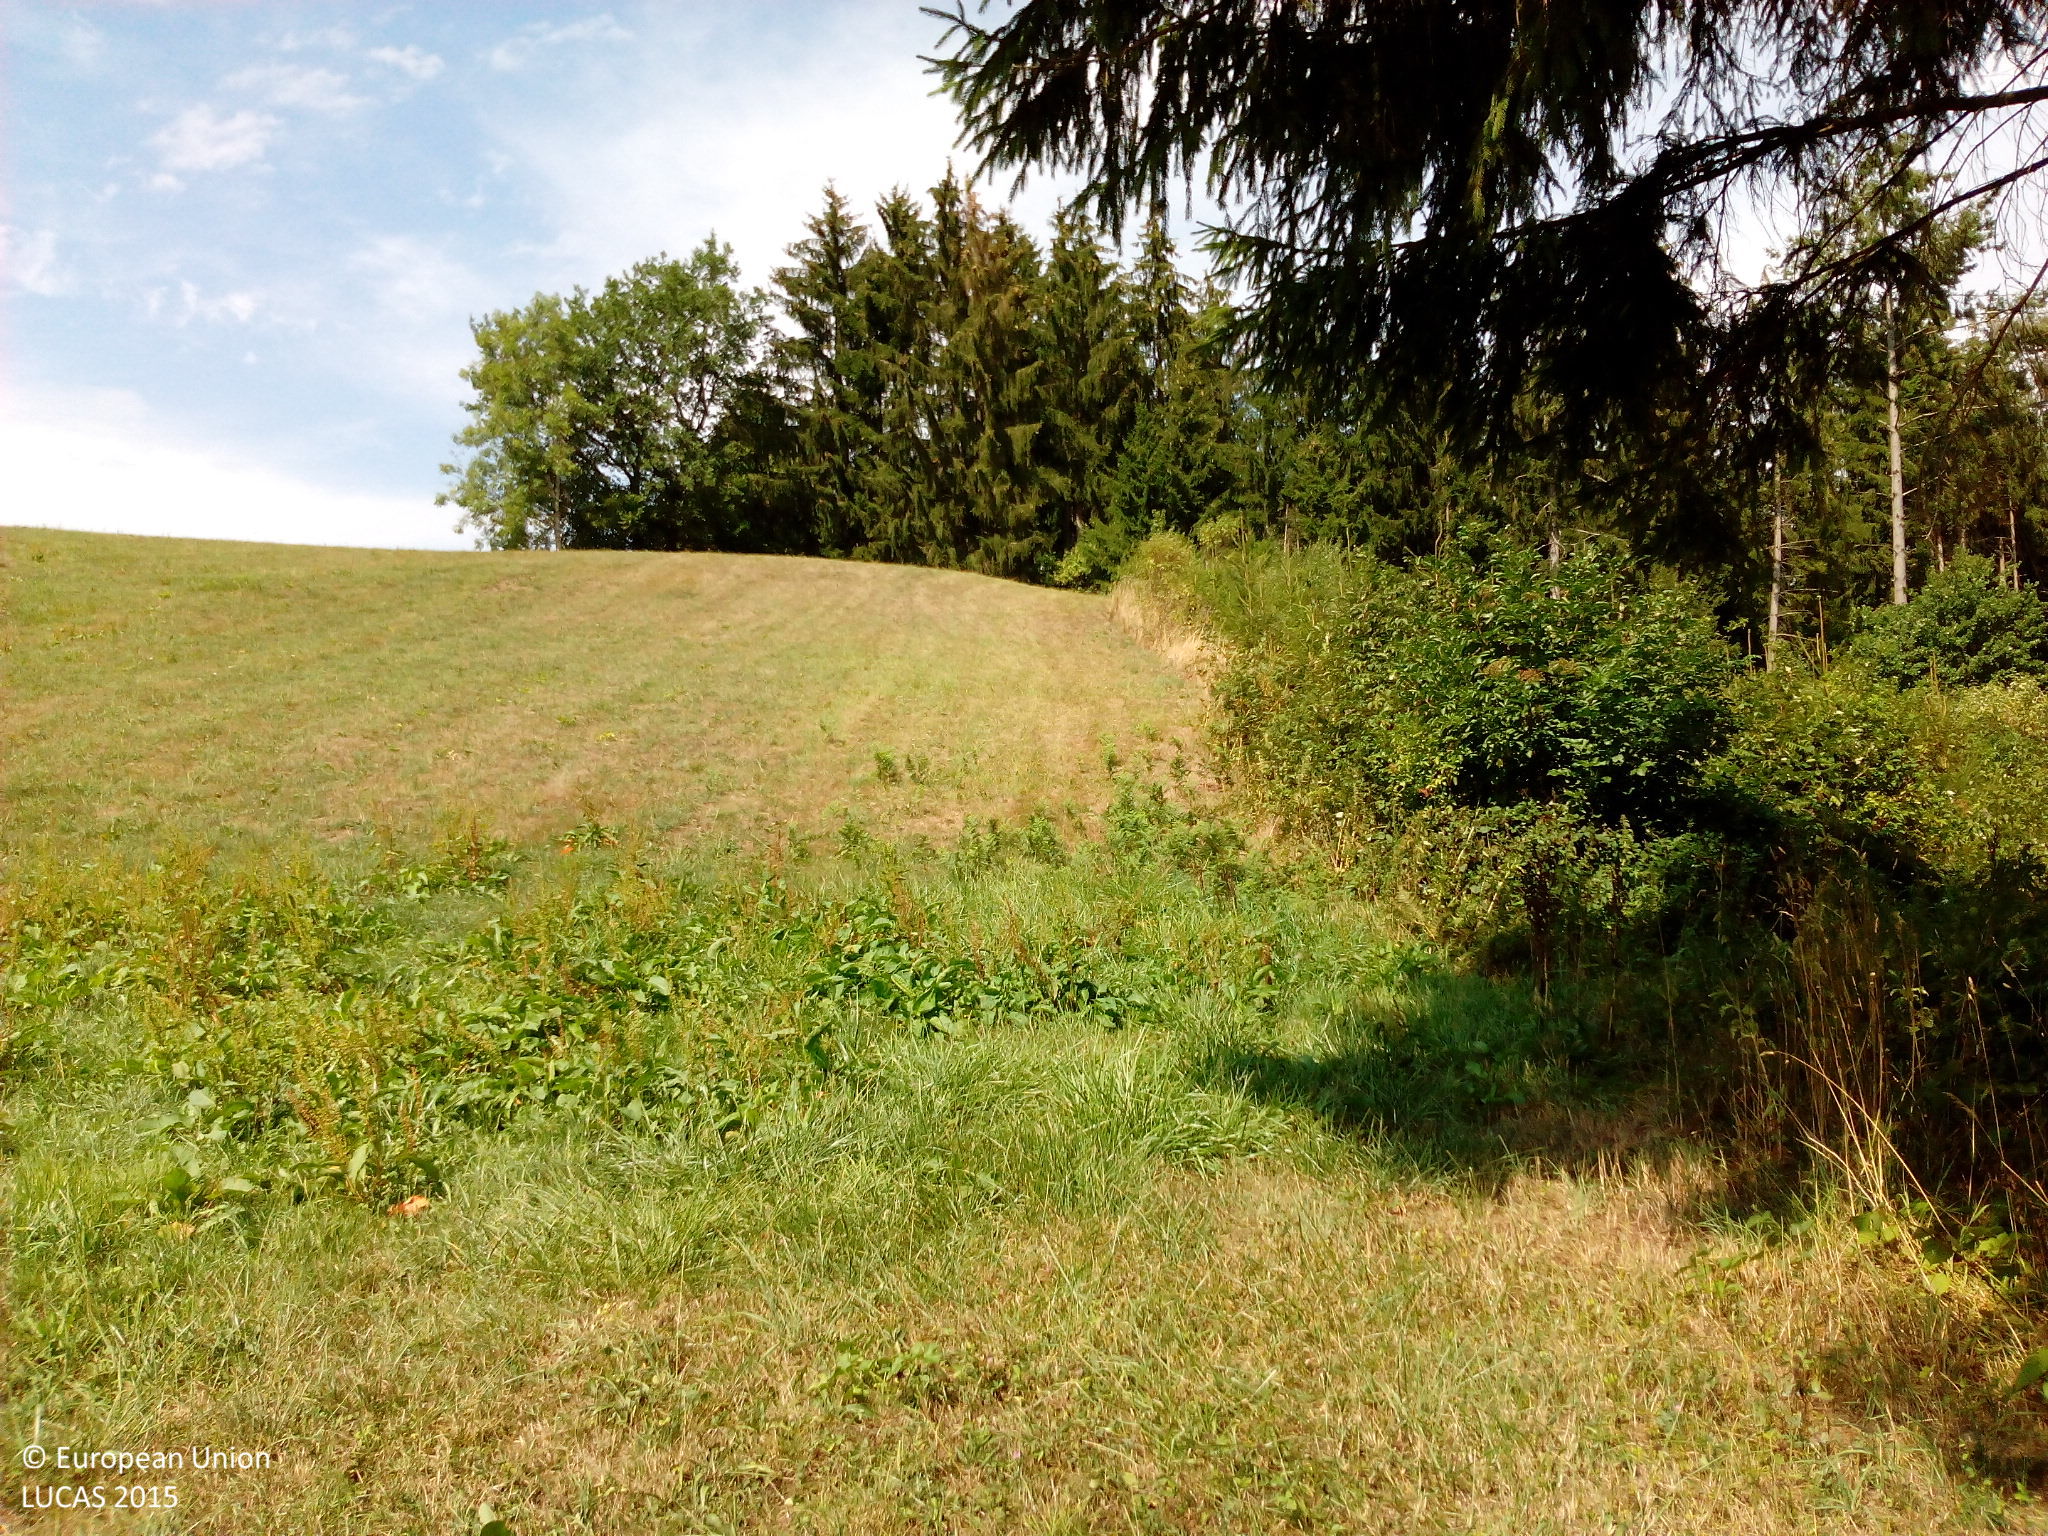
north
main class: Grassland
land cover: Grassland without tree/shrub cover
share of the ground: > 75 %
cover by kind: herbaceous plants 100 %
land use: Agriculture (excluding fallow land and kitchen gardens)
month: August
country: DE
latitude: 47.6495
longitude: 8.1242
